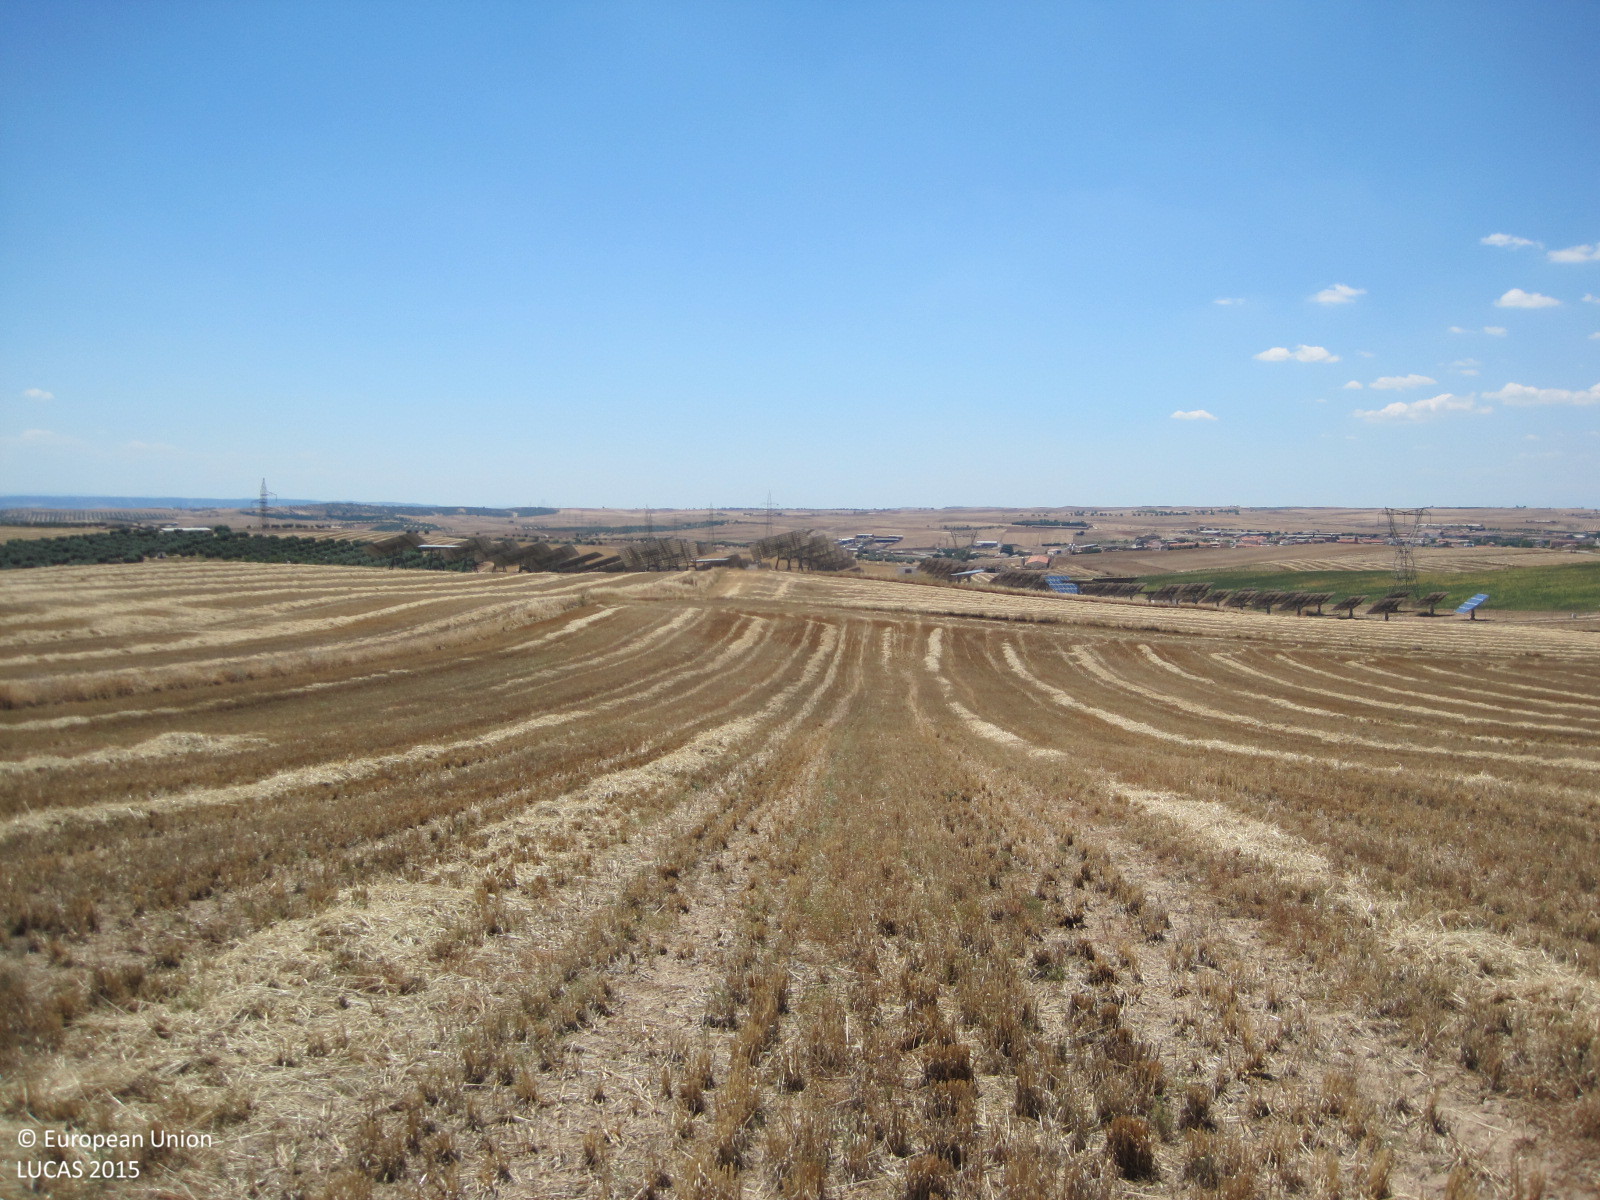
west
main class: Cropland
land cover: Barley
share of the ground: < 10 %
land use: Agriculture (excluding fallow land and kitchen gardens)
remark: Harvested field
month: June
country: ES
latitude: 39.8966
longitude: -4.2720
